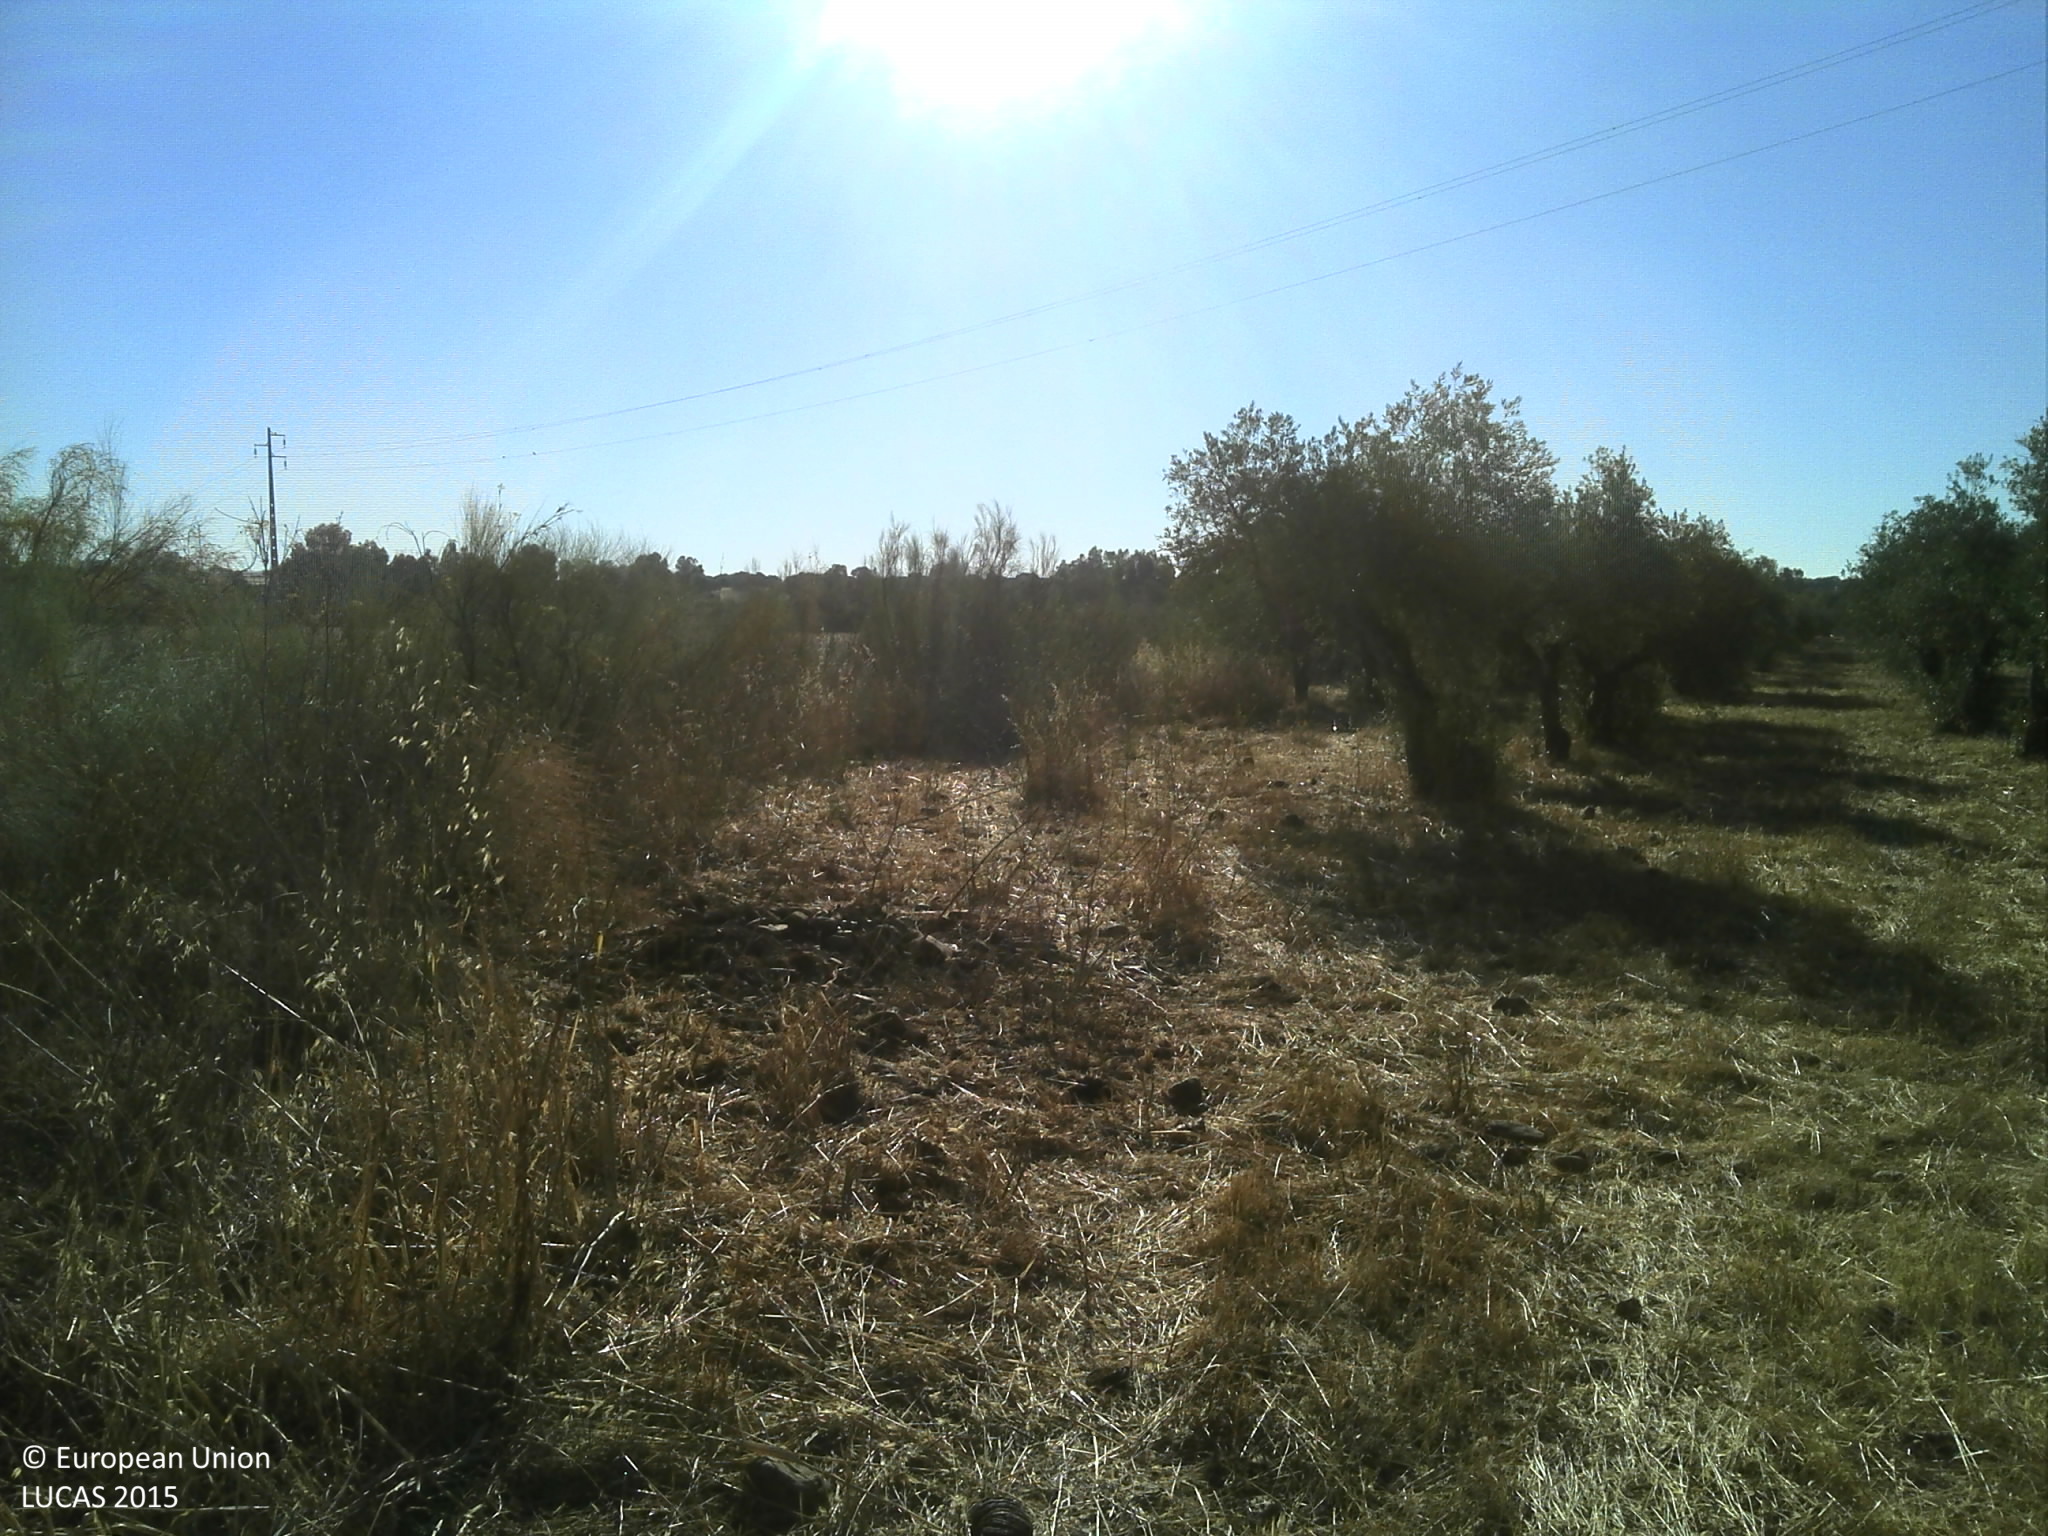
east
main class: Cropland
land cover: Olive groves
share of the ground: 25 - 50 %
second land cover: Shrubland without tree cover
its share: 10 - 25 %
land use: Agriculture (excluding fallow land and kitchen gardens)
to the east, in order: Olive groves; Shrubland without tree cover; Olive groves; Shruby margins; Ditches and canals; Shruby margins; Fences; Spontaneously vegetated surfaces; Fences; Shruby margins
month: July
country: PT
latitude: 39.0967
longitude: -7.0374
